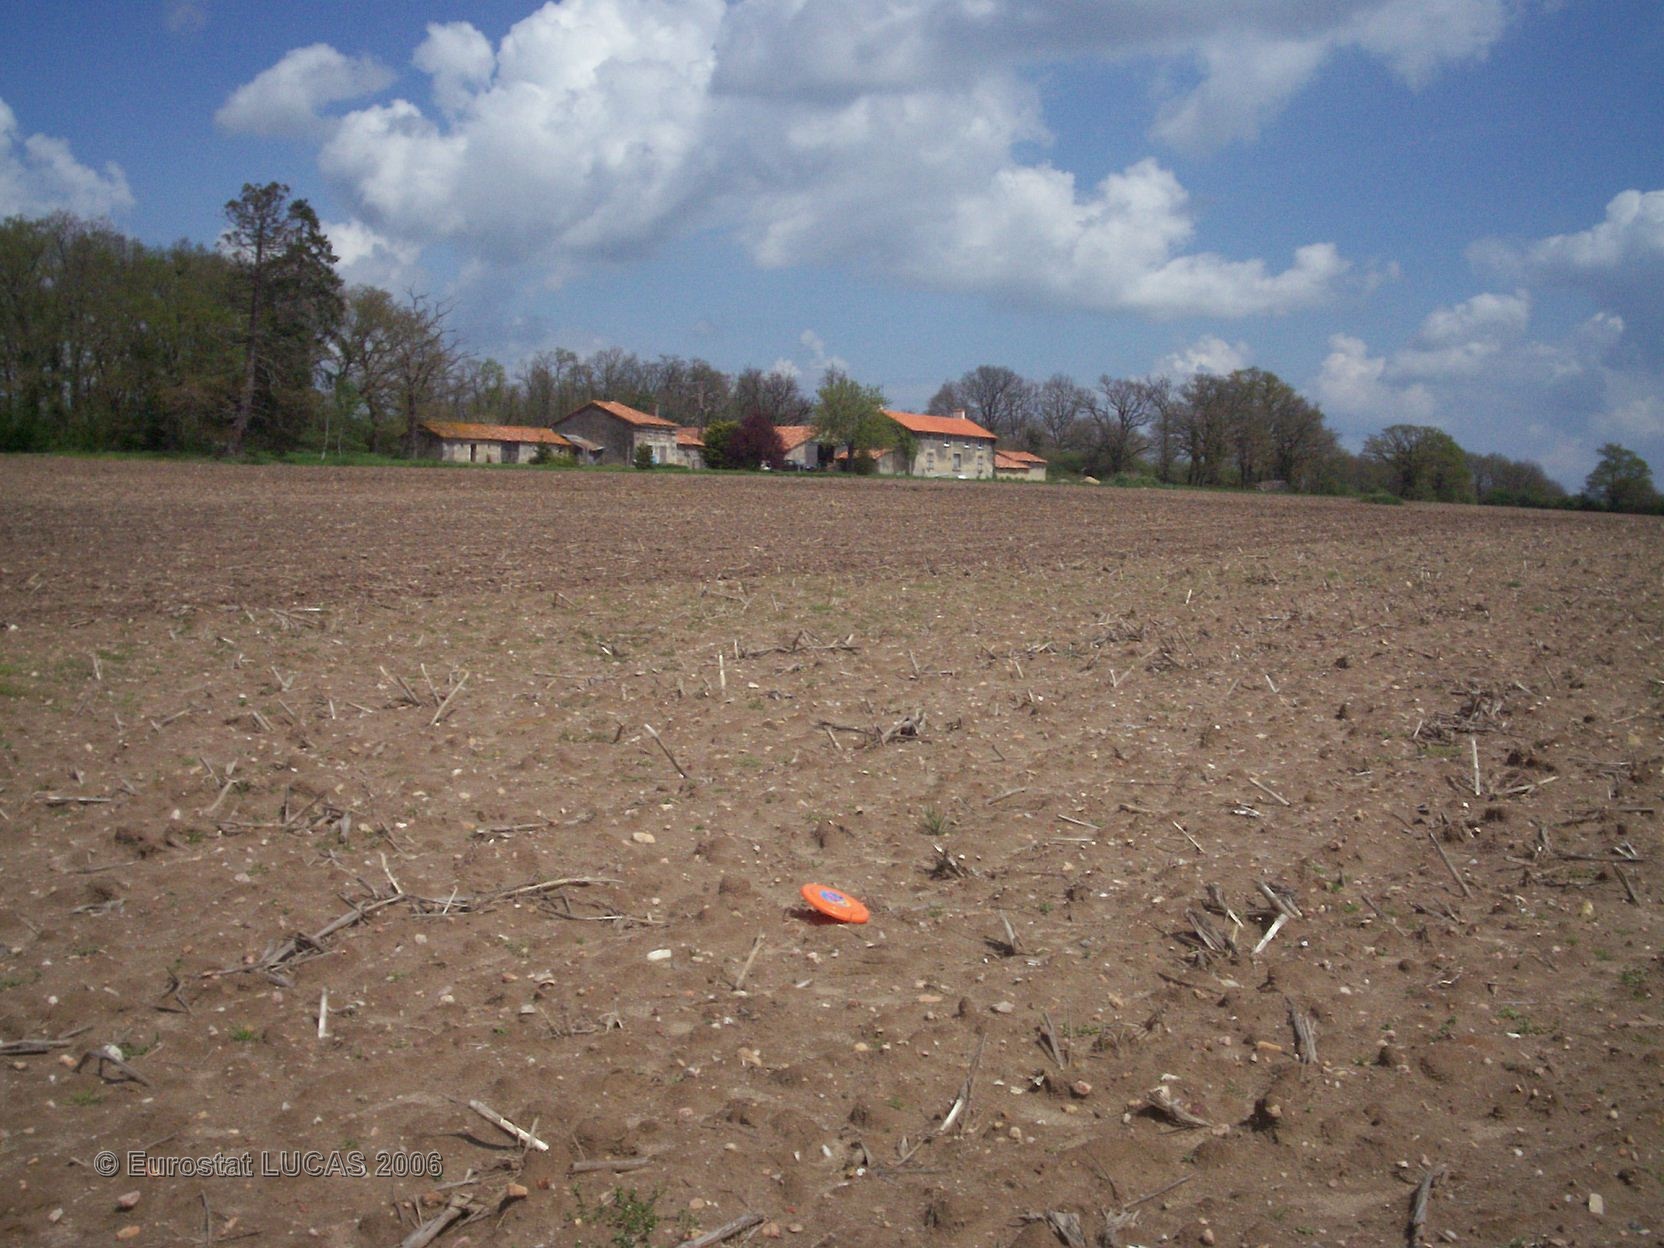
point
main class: Cropland
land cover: Maize
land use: Agriculture (excluding fallow land and kitchen gardens)
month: June
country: FR
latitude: 46.3098
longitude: 0.5174
